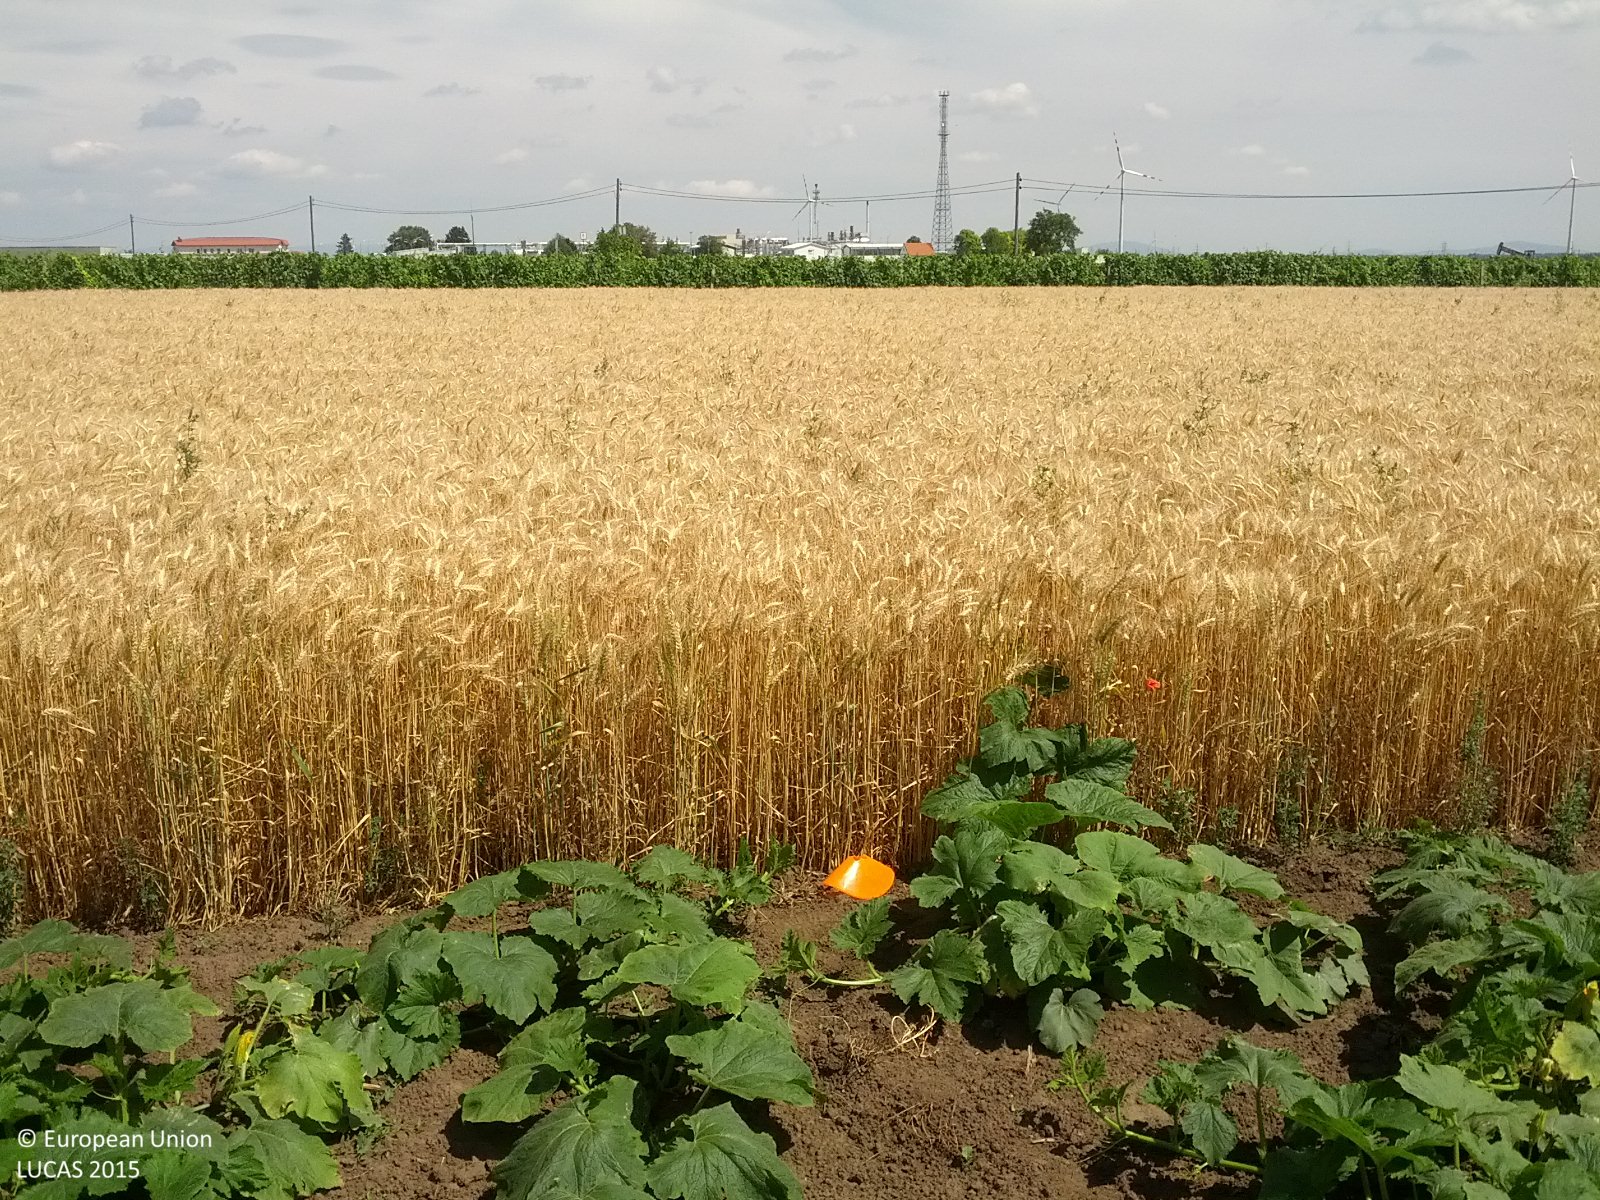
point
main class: Cropland
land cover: Other fresh vegetables
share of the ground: > 75 %
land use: Agriculture (excluding fallow land and kitchen gardens)
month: June
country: AT
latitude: 48.3667
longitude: 16.6340
